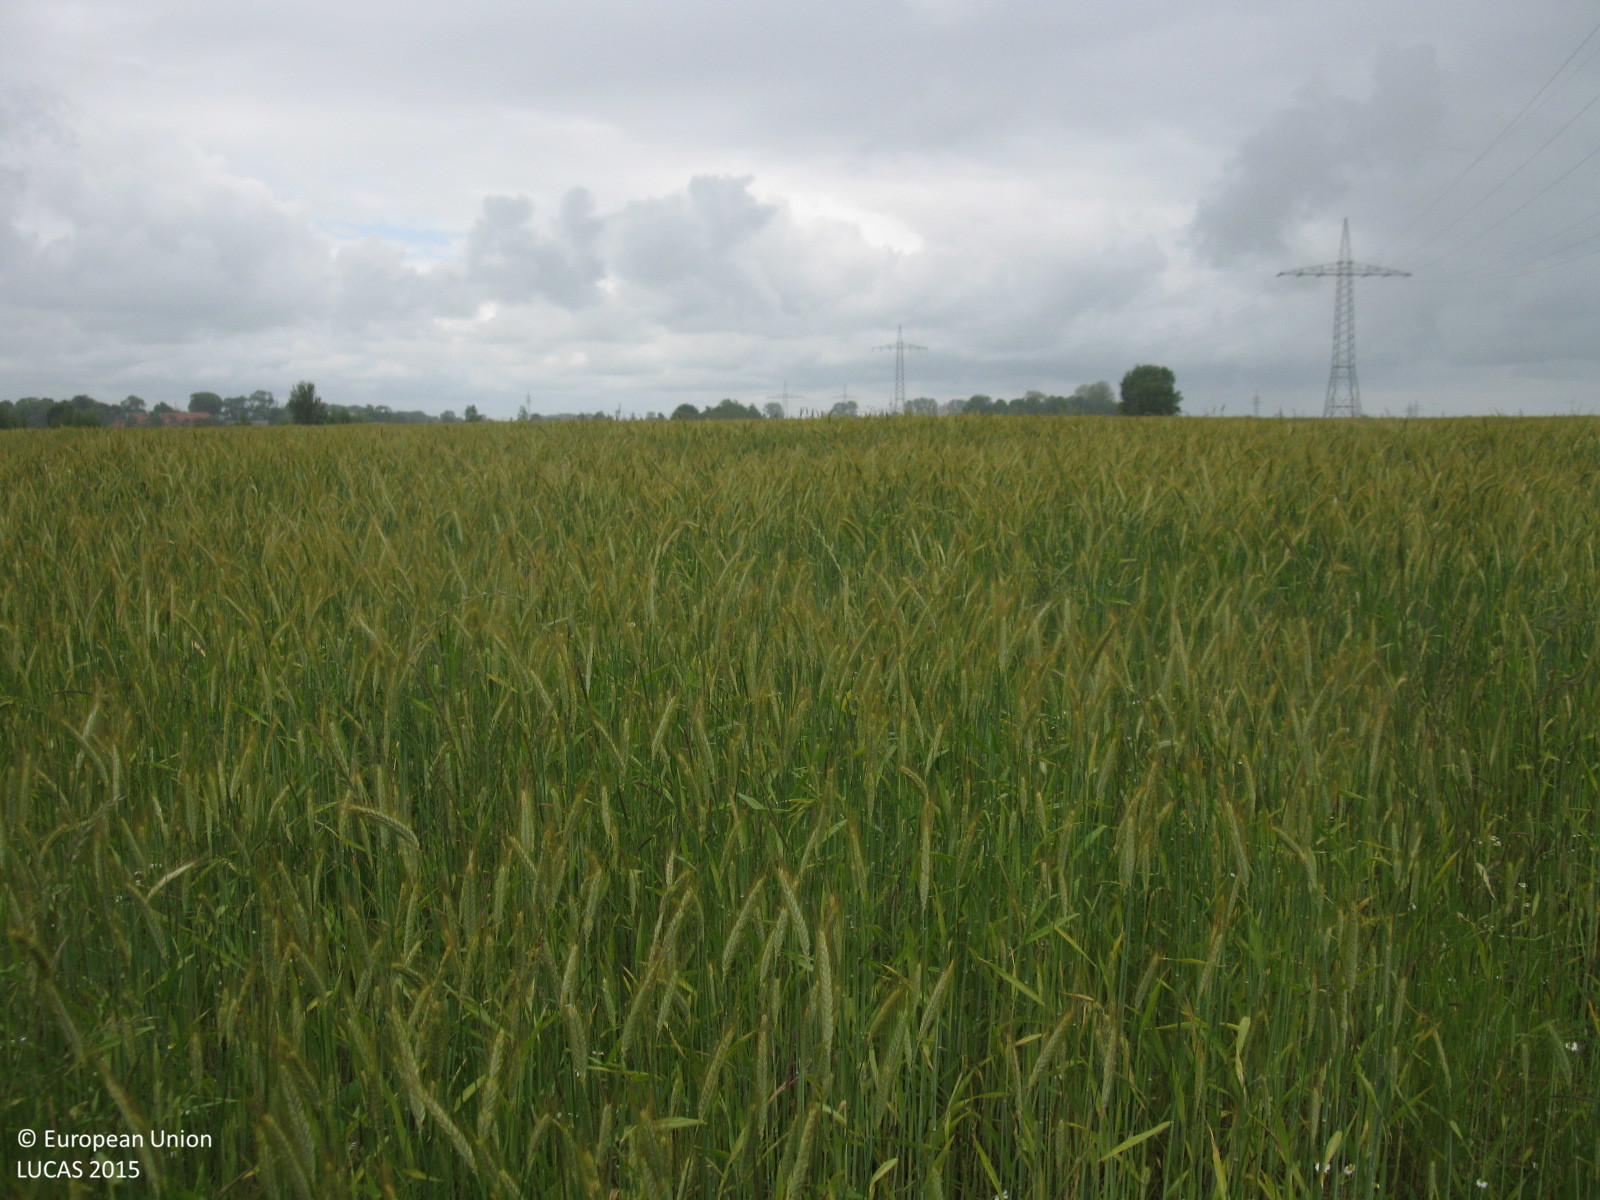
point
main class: Cropland
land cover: Triticale
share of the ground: > 75 %
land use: Agriculture (excluding fallow land and kitchen gardens)
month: June
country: DE
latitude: 53.6724
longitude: 7.9573
